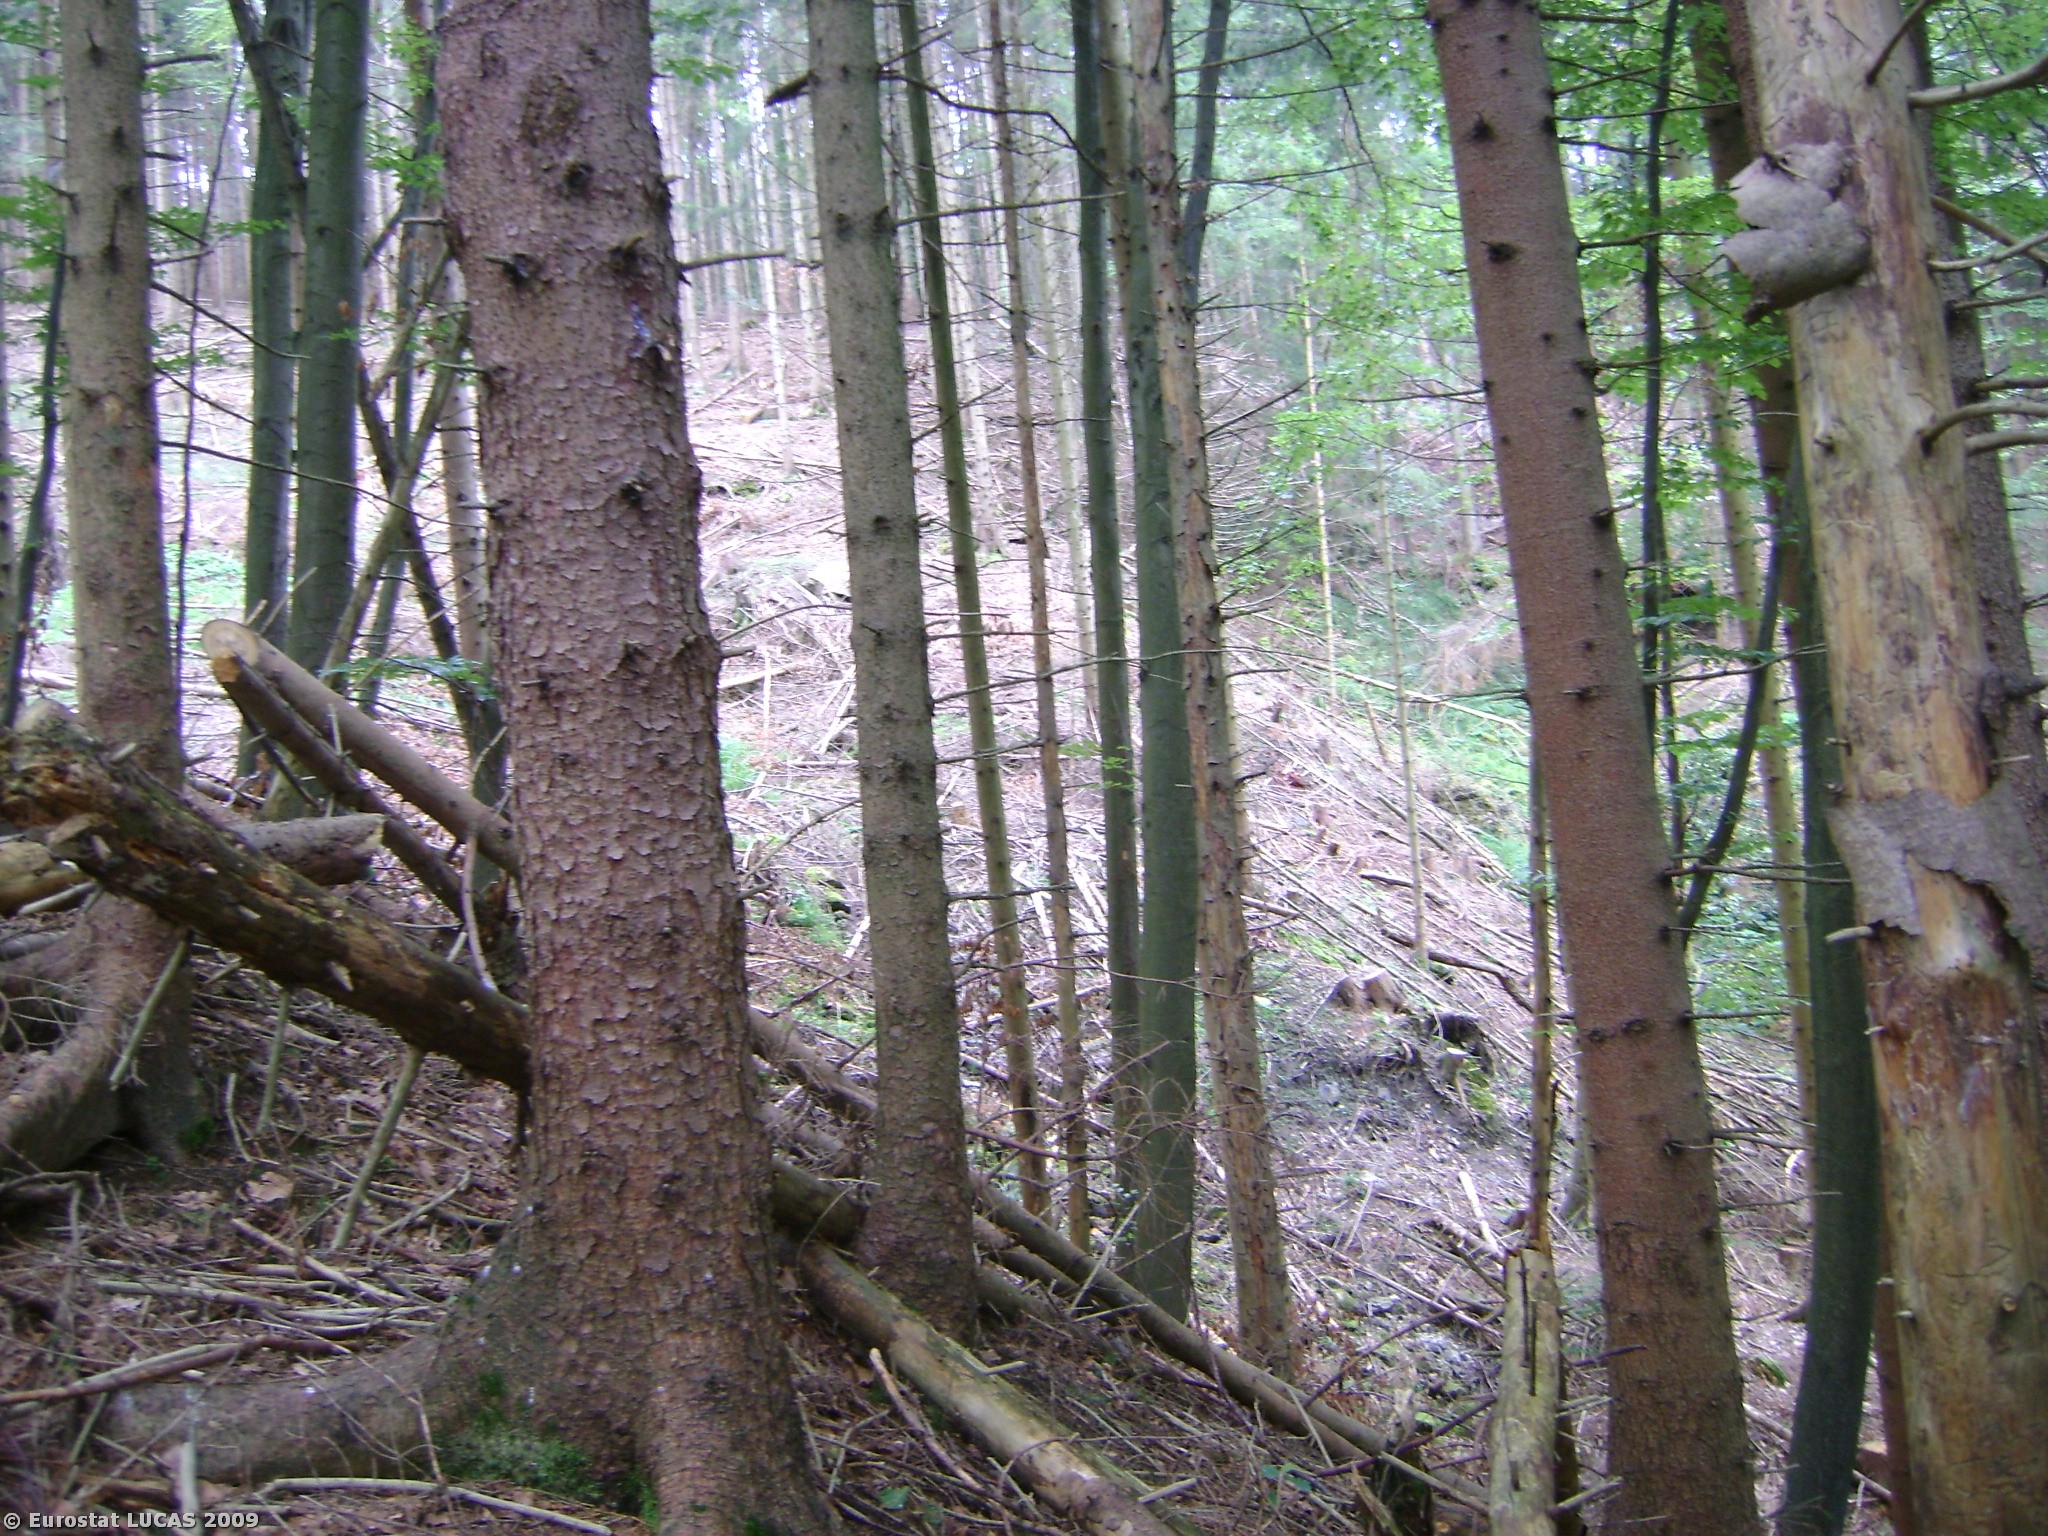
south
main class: Woodland
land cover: Mixed woodland
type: hemiboreal forest and nemoral coniferous forest and mixed broadleaved-coniferous forest
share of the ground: > 75 %
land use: Forestry
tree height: > 5 m
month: August
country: AT
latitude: 47.9055
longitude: 13.2497
